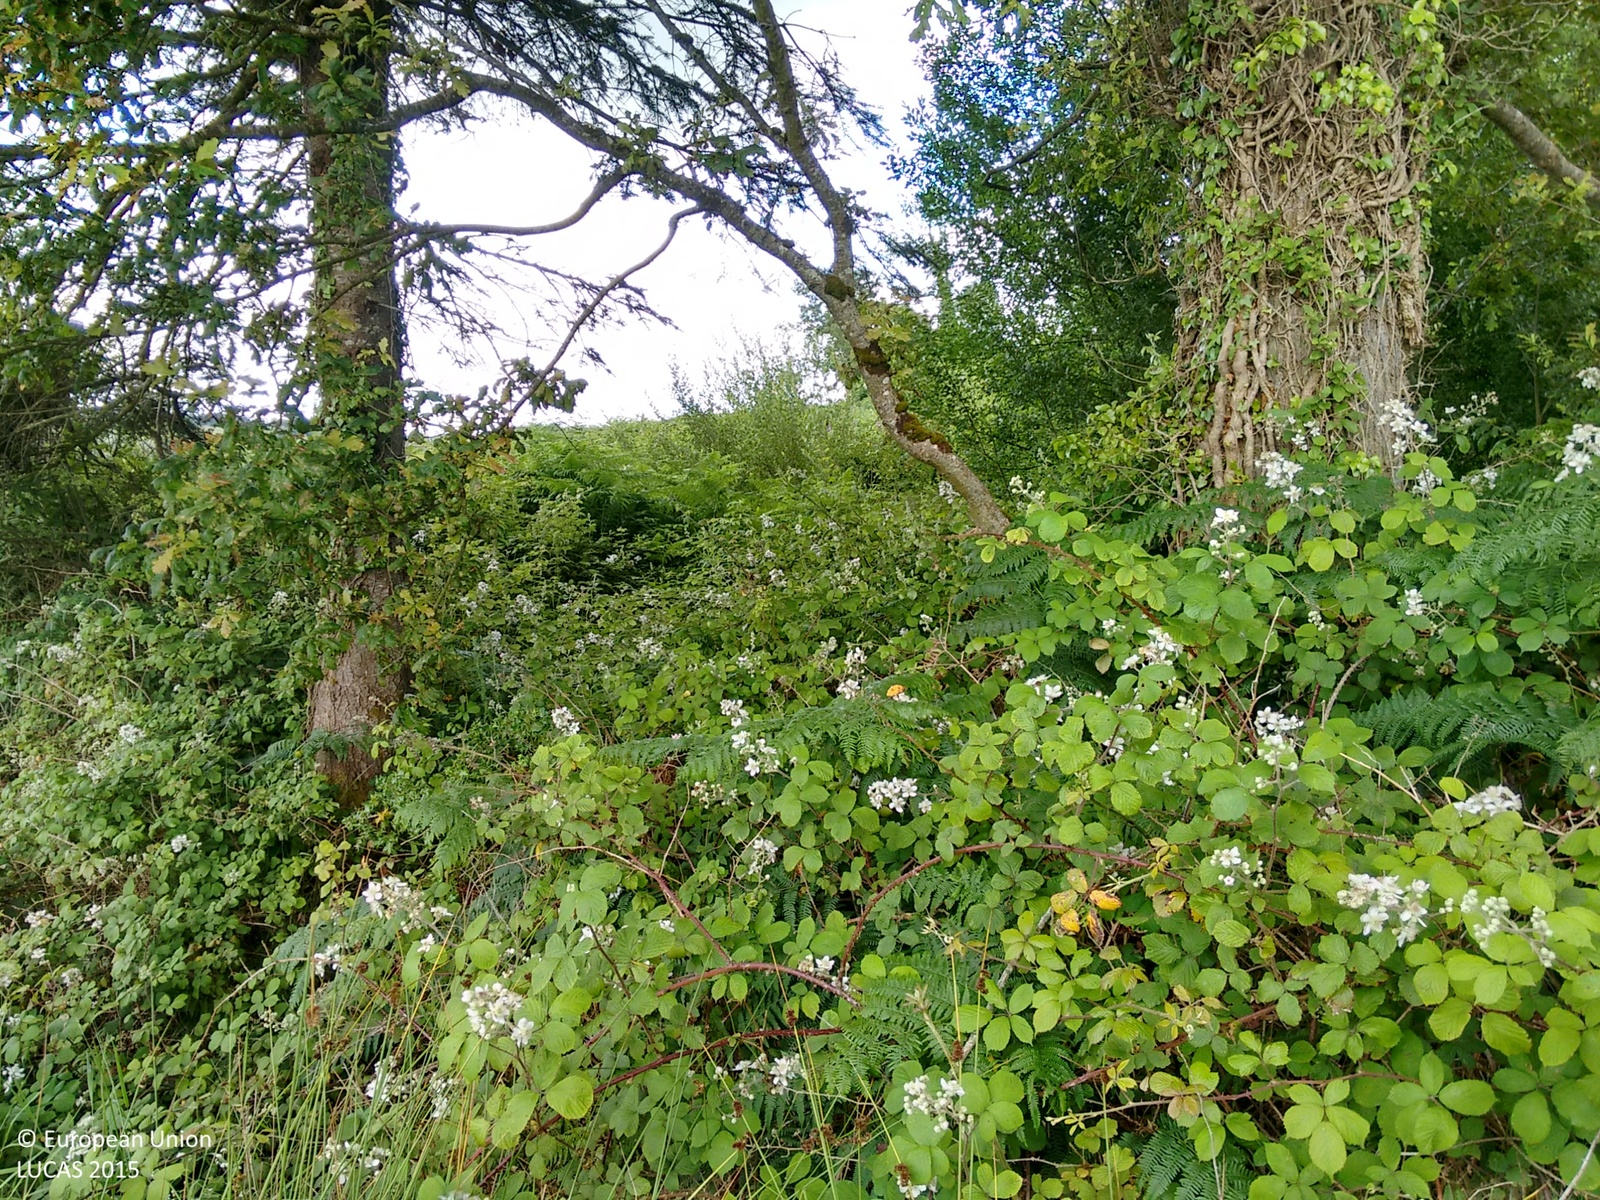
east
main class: Shrubland
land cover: Shrubland with sparse tree cover
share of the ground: > 75 %
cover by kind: shrubs 70 %, herbaceous plants 15 %, lichens and mosses 10 %, broadleaved forest trees 5 %
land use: Semi-natural and natural areas not in use
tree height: > 5 m
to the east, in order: Shrubland with sparse tree cover; Grassland with sparse tree/shrub cover; Shruby margins; Fences; Grassland without tree/shrub cover; Fences; Grassland without tree/shrub cover
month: July
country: IE
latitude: 52.8798
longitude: -8.3925
